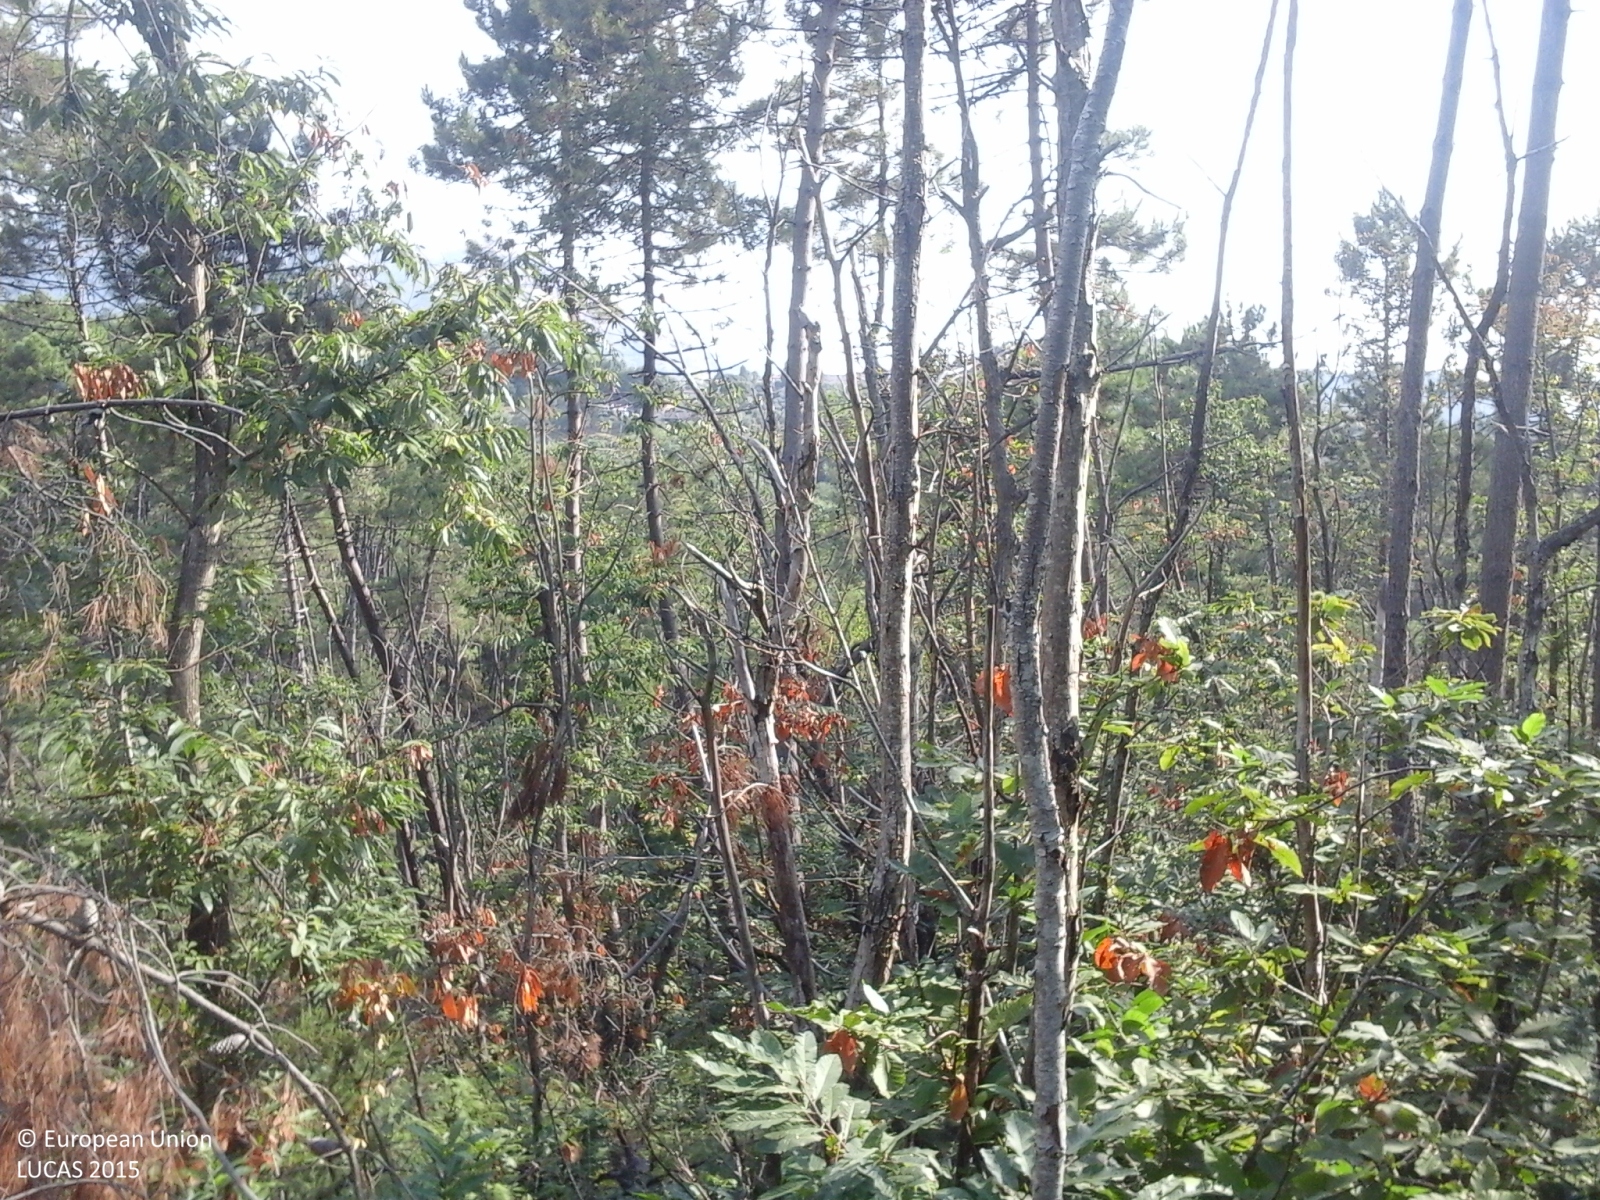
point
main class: Woodland
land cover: Other mixed woodland
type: thermophilous deciduous forest
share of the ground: > 75 %
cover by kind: broadleaved forest trees 60 %, coniferous forest trees 30 %, shrubs 10 %
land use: Forestry
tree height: > 5 m
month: August
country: IT
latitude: 43.8990
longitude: 10.3353
